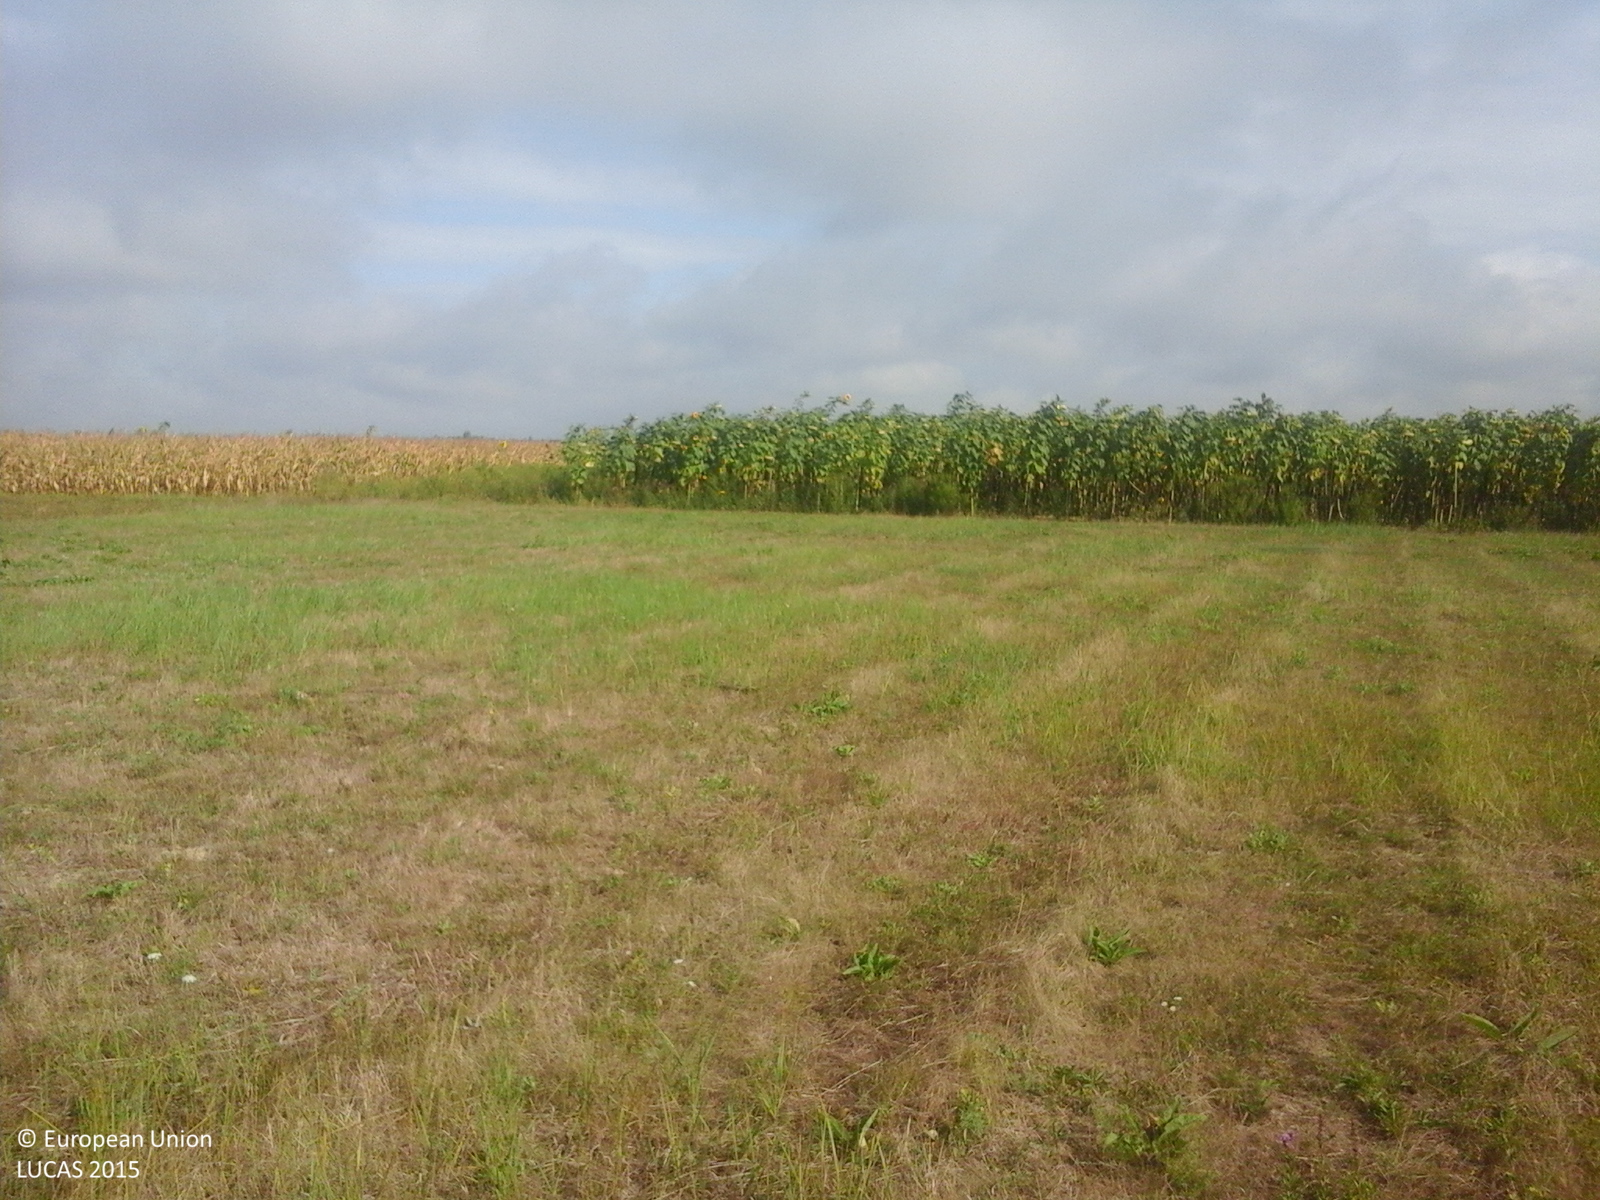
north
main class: Grassland
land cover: Grassland without tree/shrub cover
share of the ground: > 75 %
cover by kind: herbaceous plants 100 %
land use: Agriculture (excluding fallow land and kitchen gardens)
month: September
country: RO
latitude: 47.9643
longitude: 22.9648
